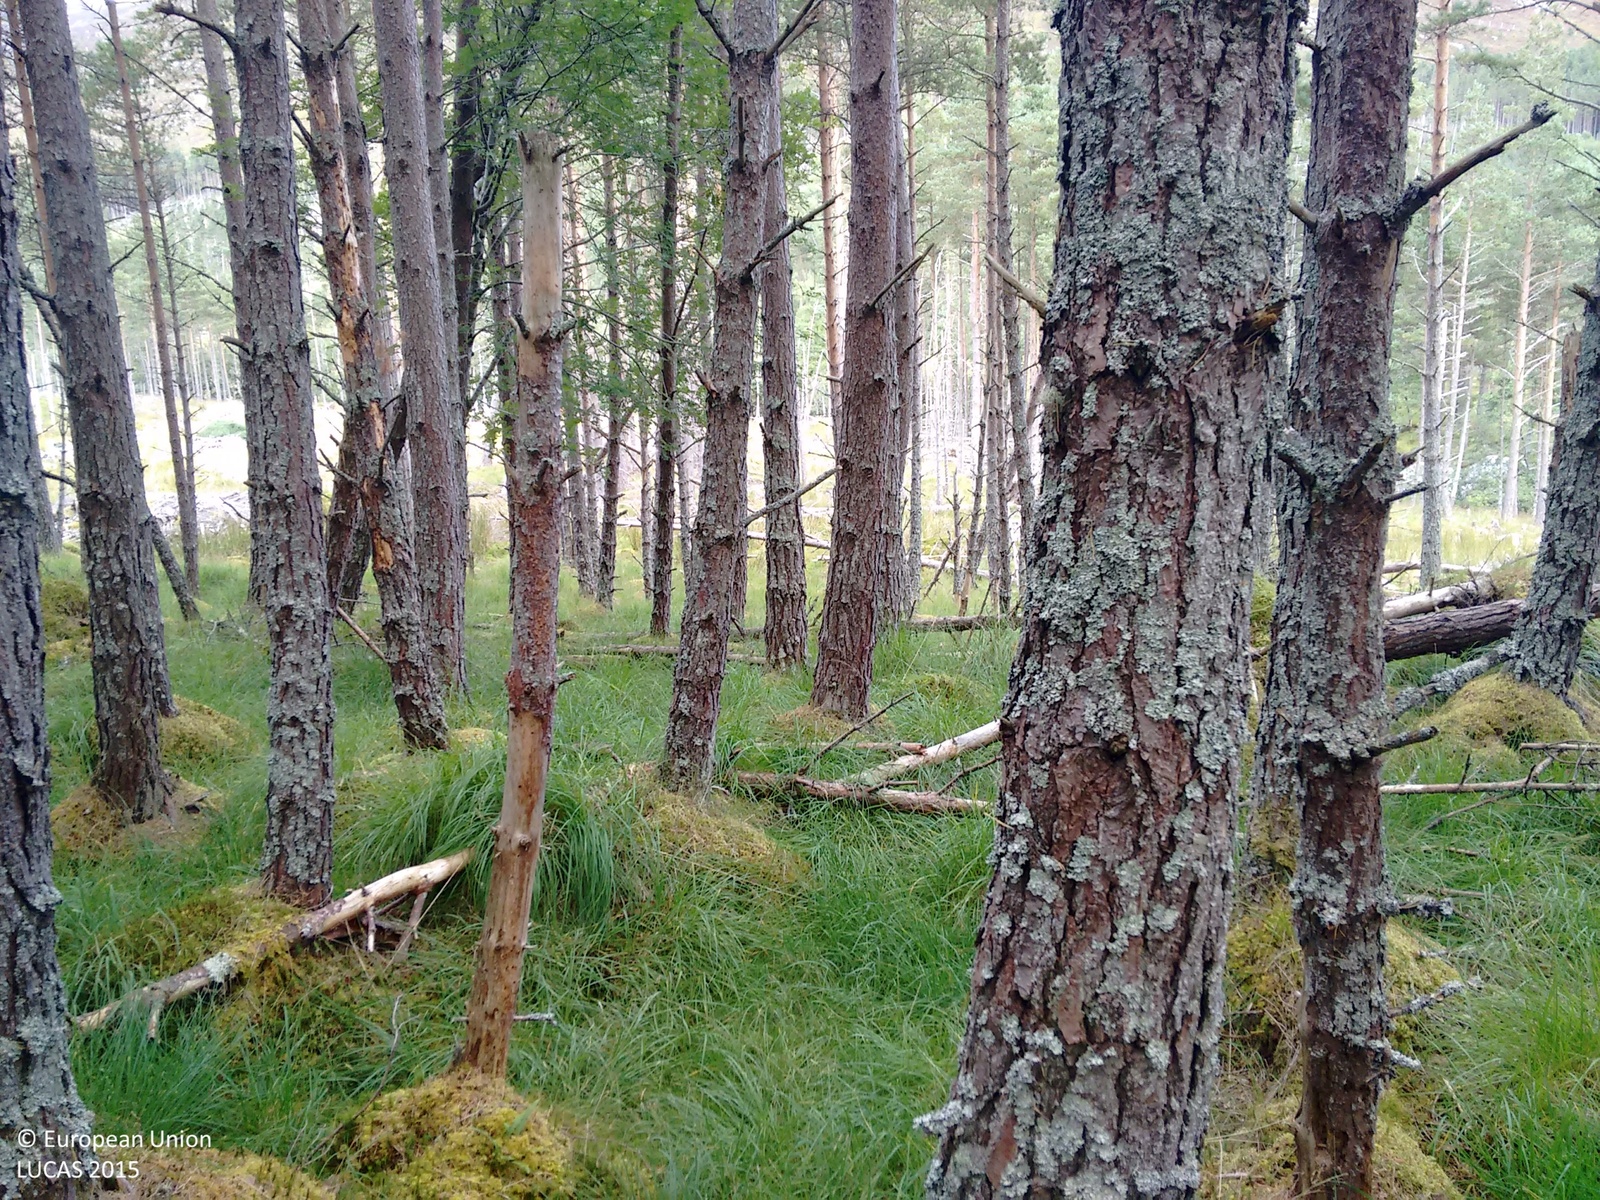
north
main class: Woodland
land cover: Pine dominated coniferous woodland
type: exotic forest
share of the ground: > 75 %
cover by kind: coniferous forest trees 100 %
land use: Forestry
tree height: > 5 m
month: September
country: GB
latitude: 57.5310
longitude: -4.8803
